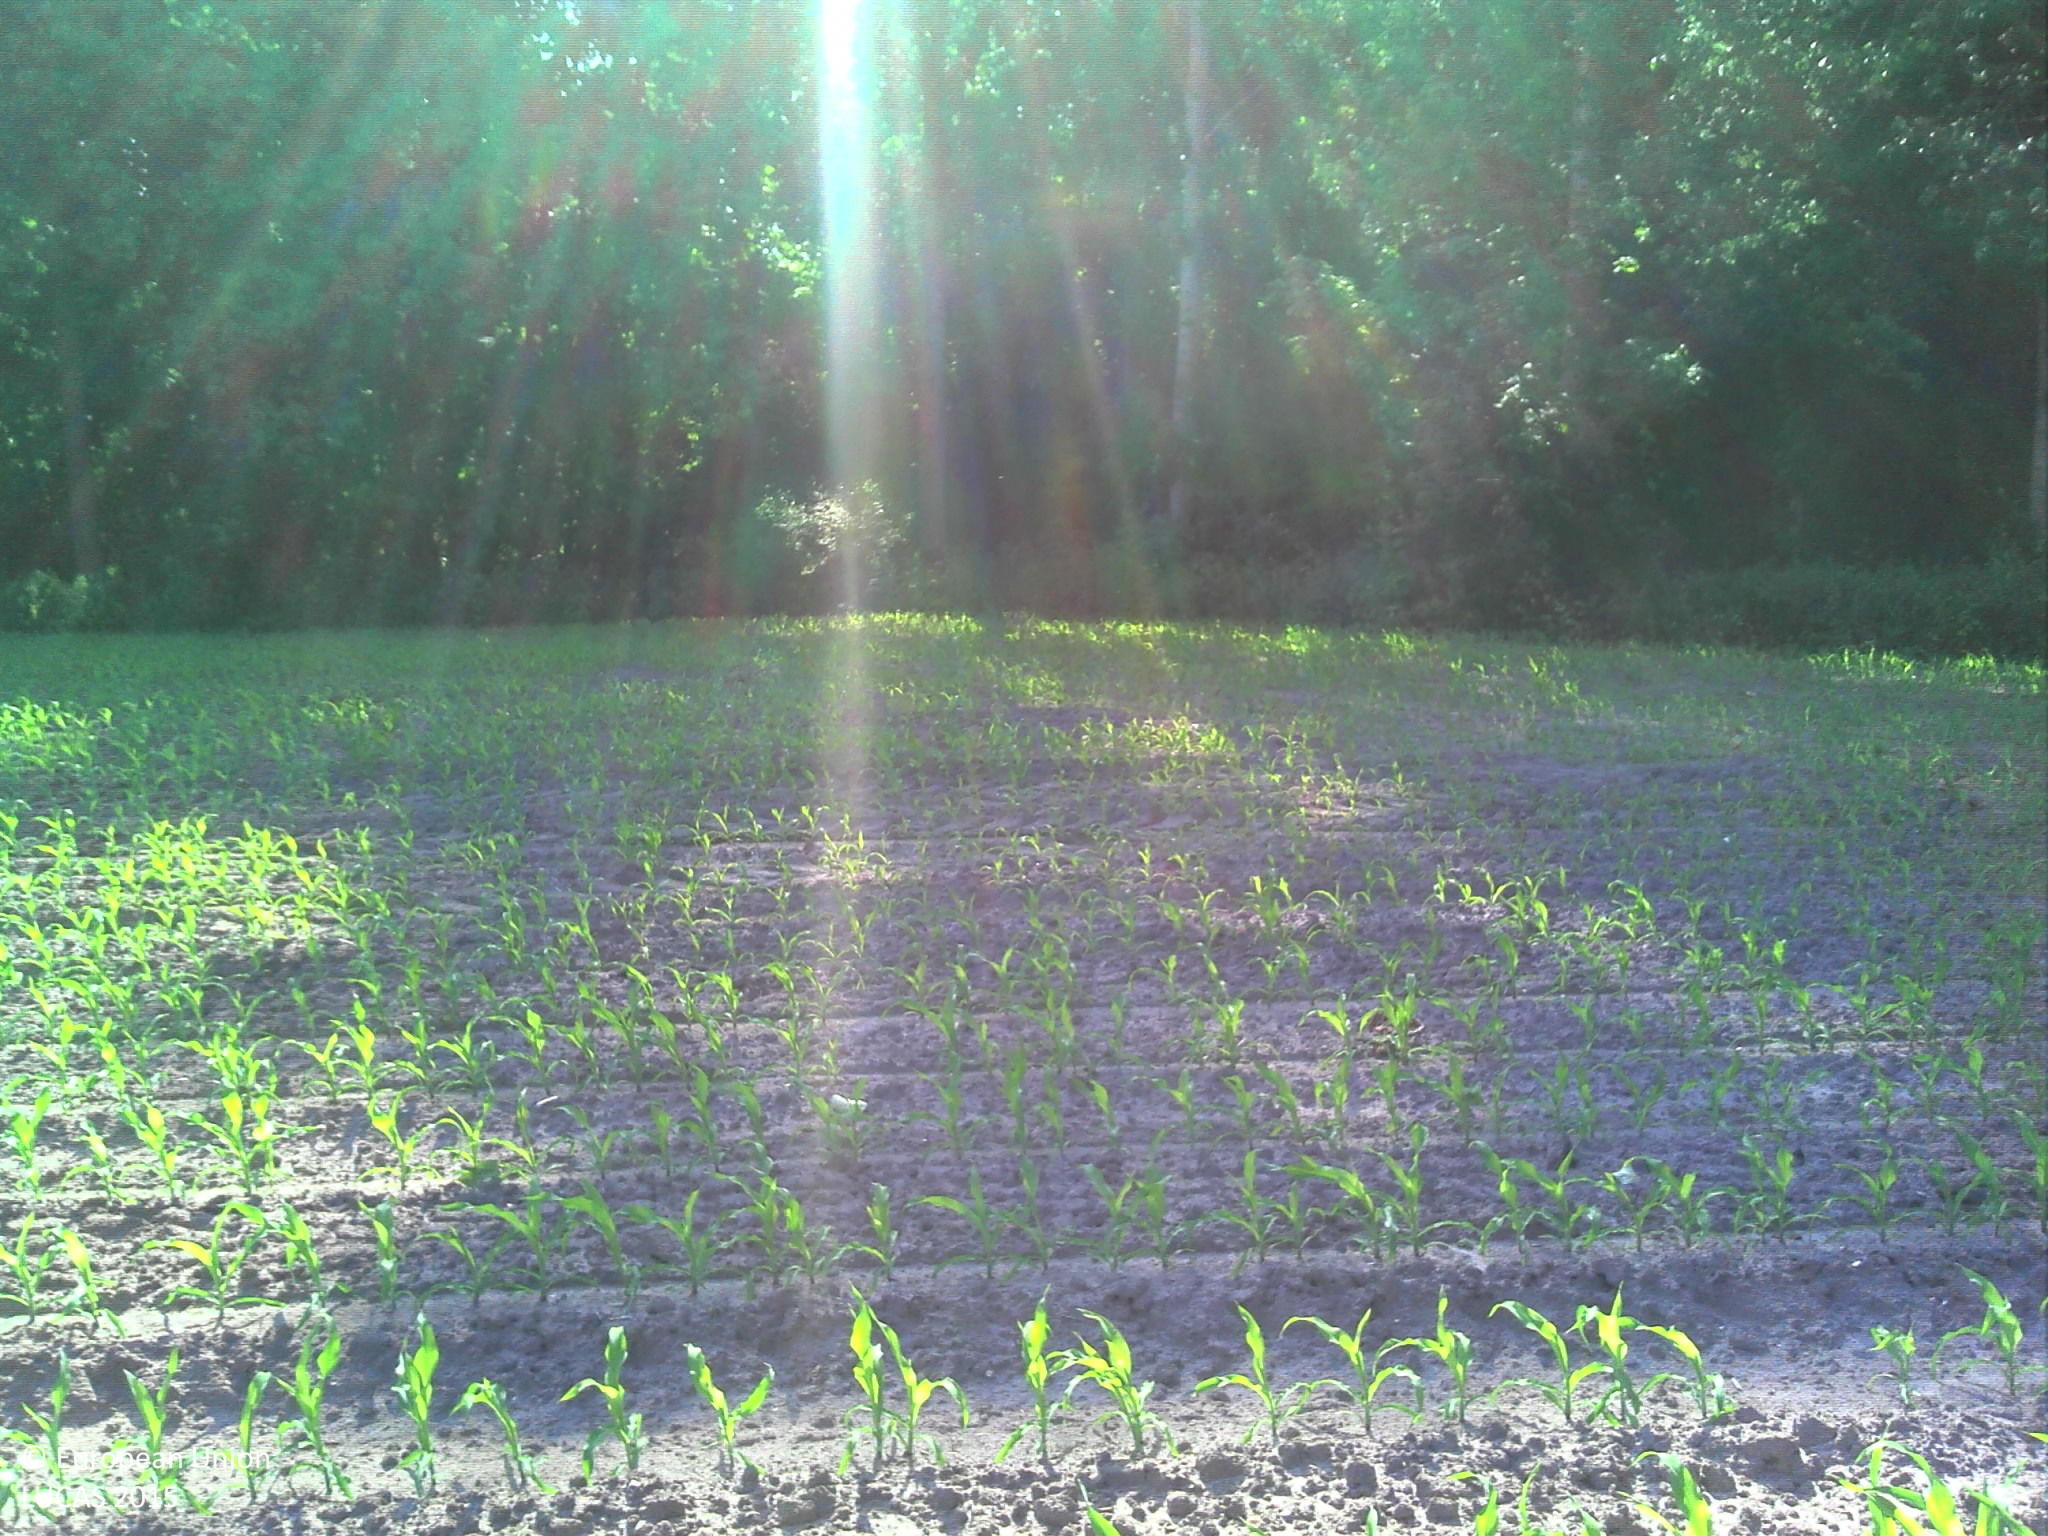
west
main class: Cropland
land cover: Maize
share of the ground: 10 - 25 %
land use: Agriculture (excluding fallow land and kitchen gardens)
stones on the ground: < 10 %
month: June
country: BE
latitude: 51.0086
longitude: 3.8222
